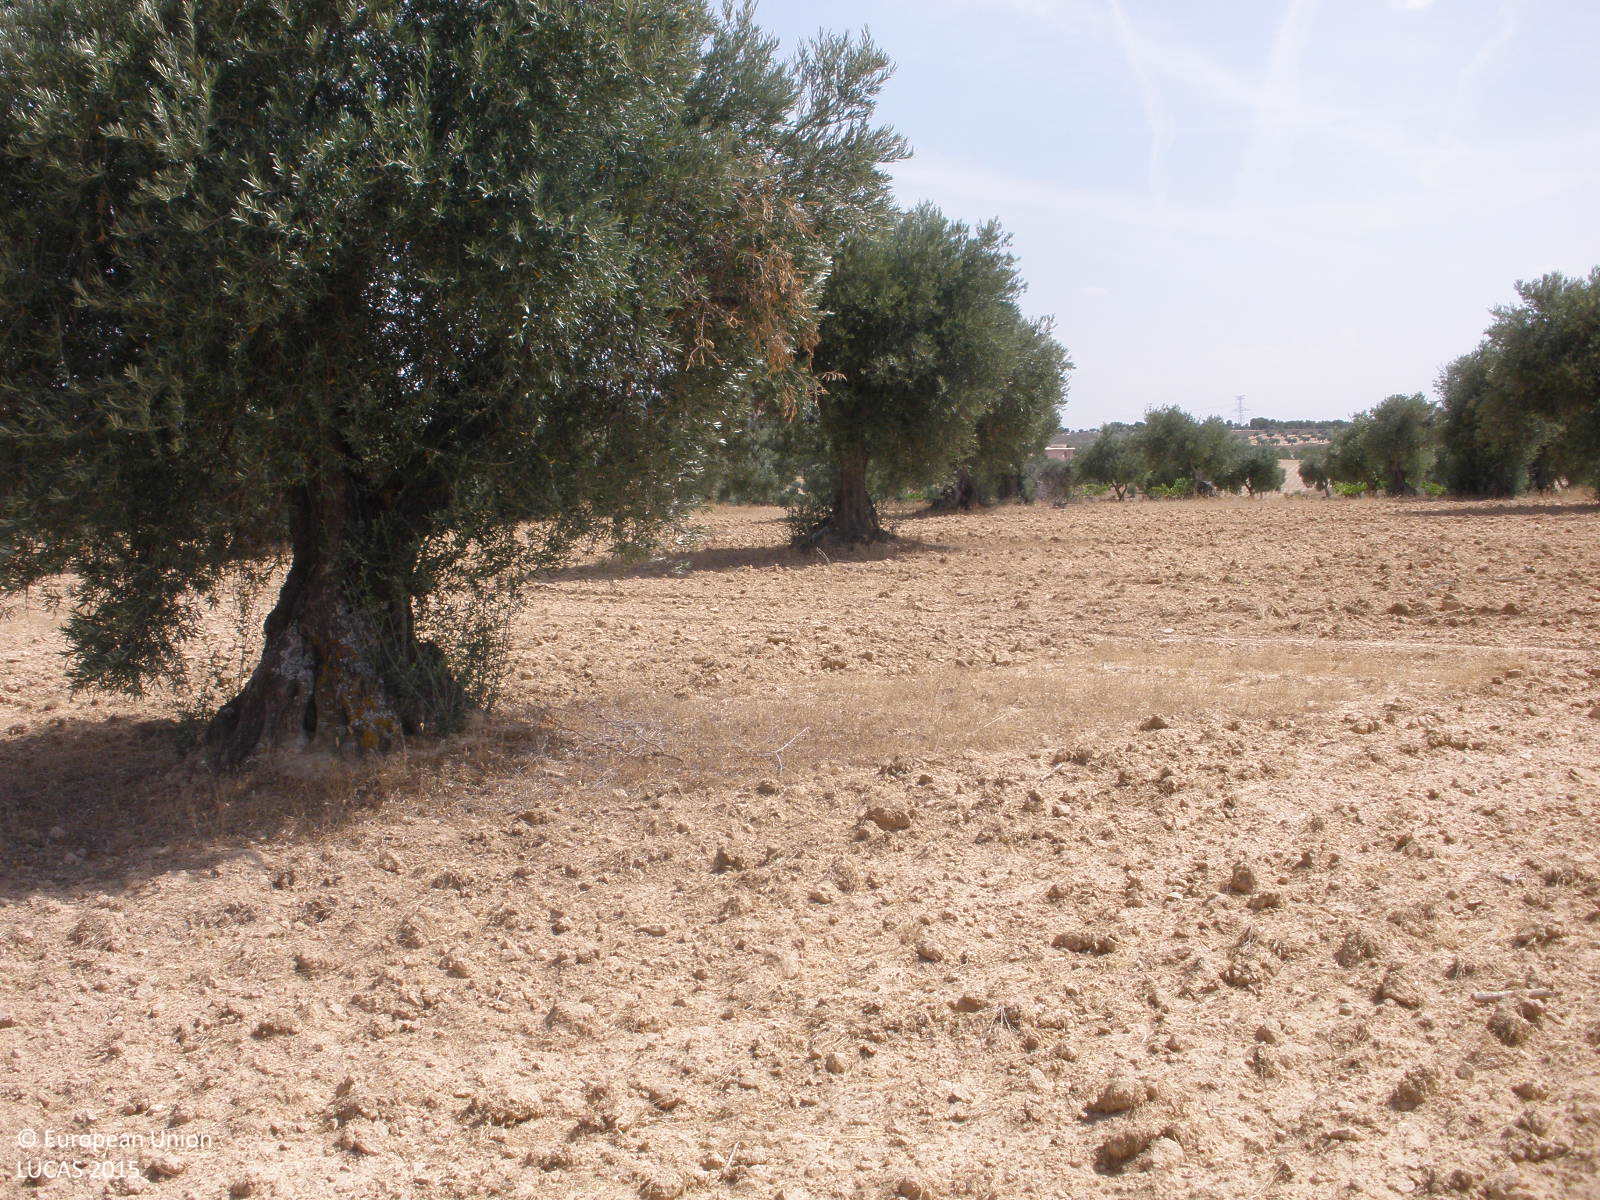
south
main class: Cropland
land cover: Olive groves
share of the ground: 25 - 50 %
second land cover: Other bare soil
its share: > 75 %
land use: Agriculture (excluding fallow land and kitchen gardens)
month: July
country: ES
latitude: 40.1605
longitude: -3.4507
